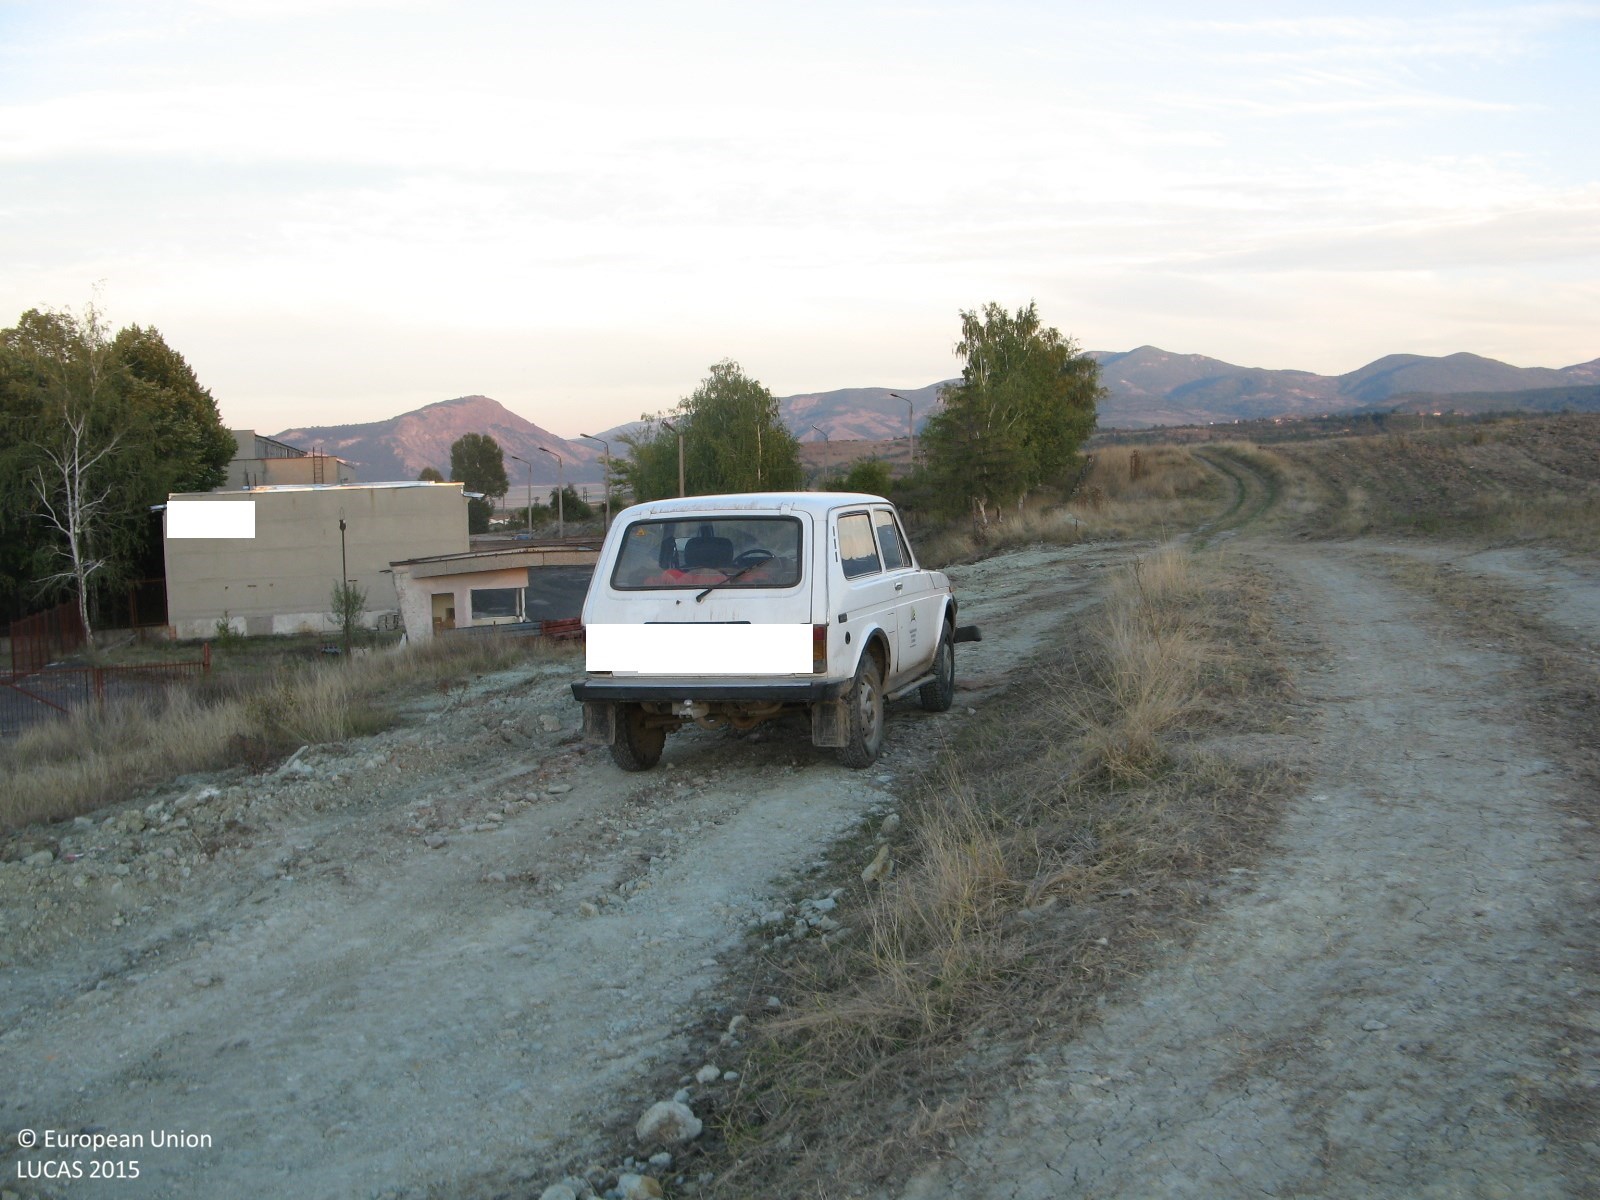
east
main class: Grassland
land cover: Spontaneously vegetated surfaces
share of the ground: > 75 %
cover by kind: herbaceous plants 100 %
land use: Fallow land
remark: Harvested field
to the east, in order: Spontaneously vegetated surfaces; Tracks; Grassland without tree/shrub cover; Artificial constructions in urban areas; Grassland without tree/shrub cover; Artificial constructions in urban areas; Grassland with sparse tree/shrub cover
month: October
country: BG
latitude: 41.6177
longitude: 25.3823
